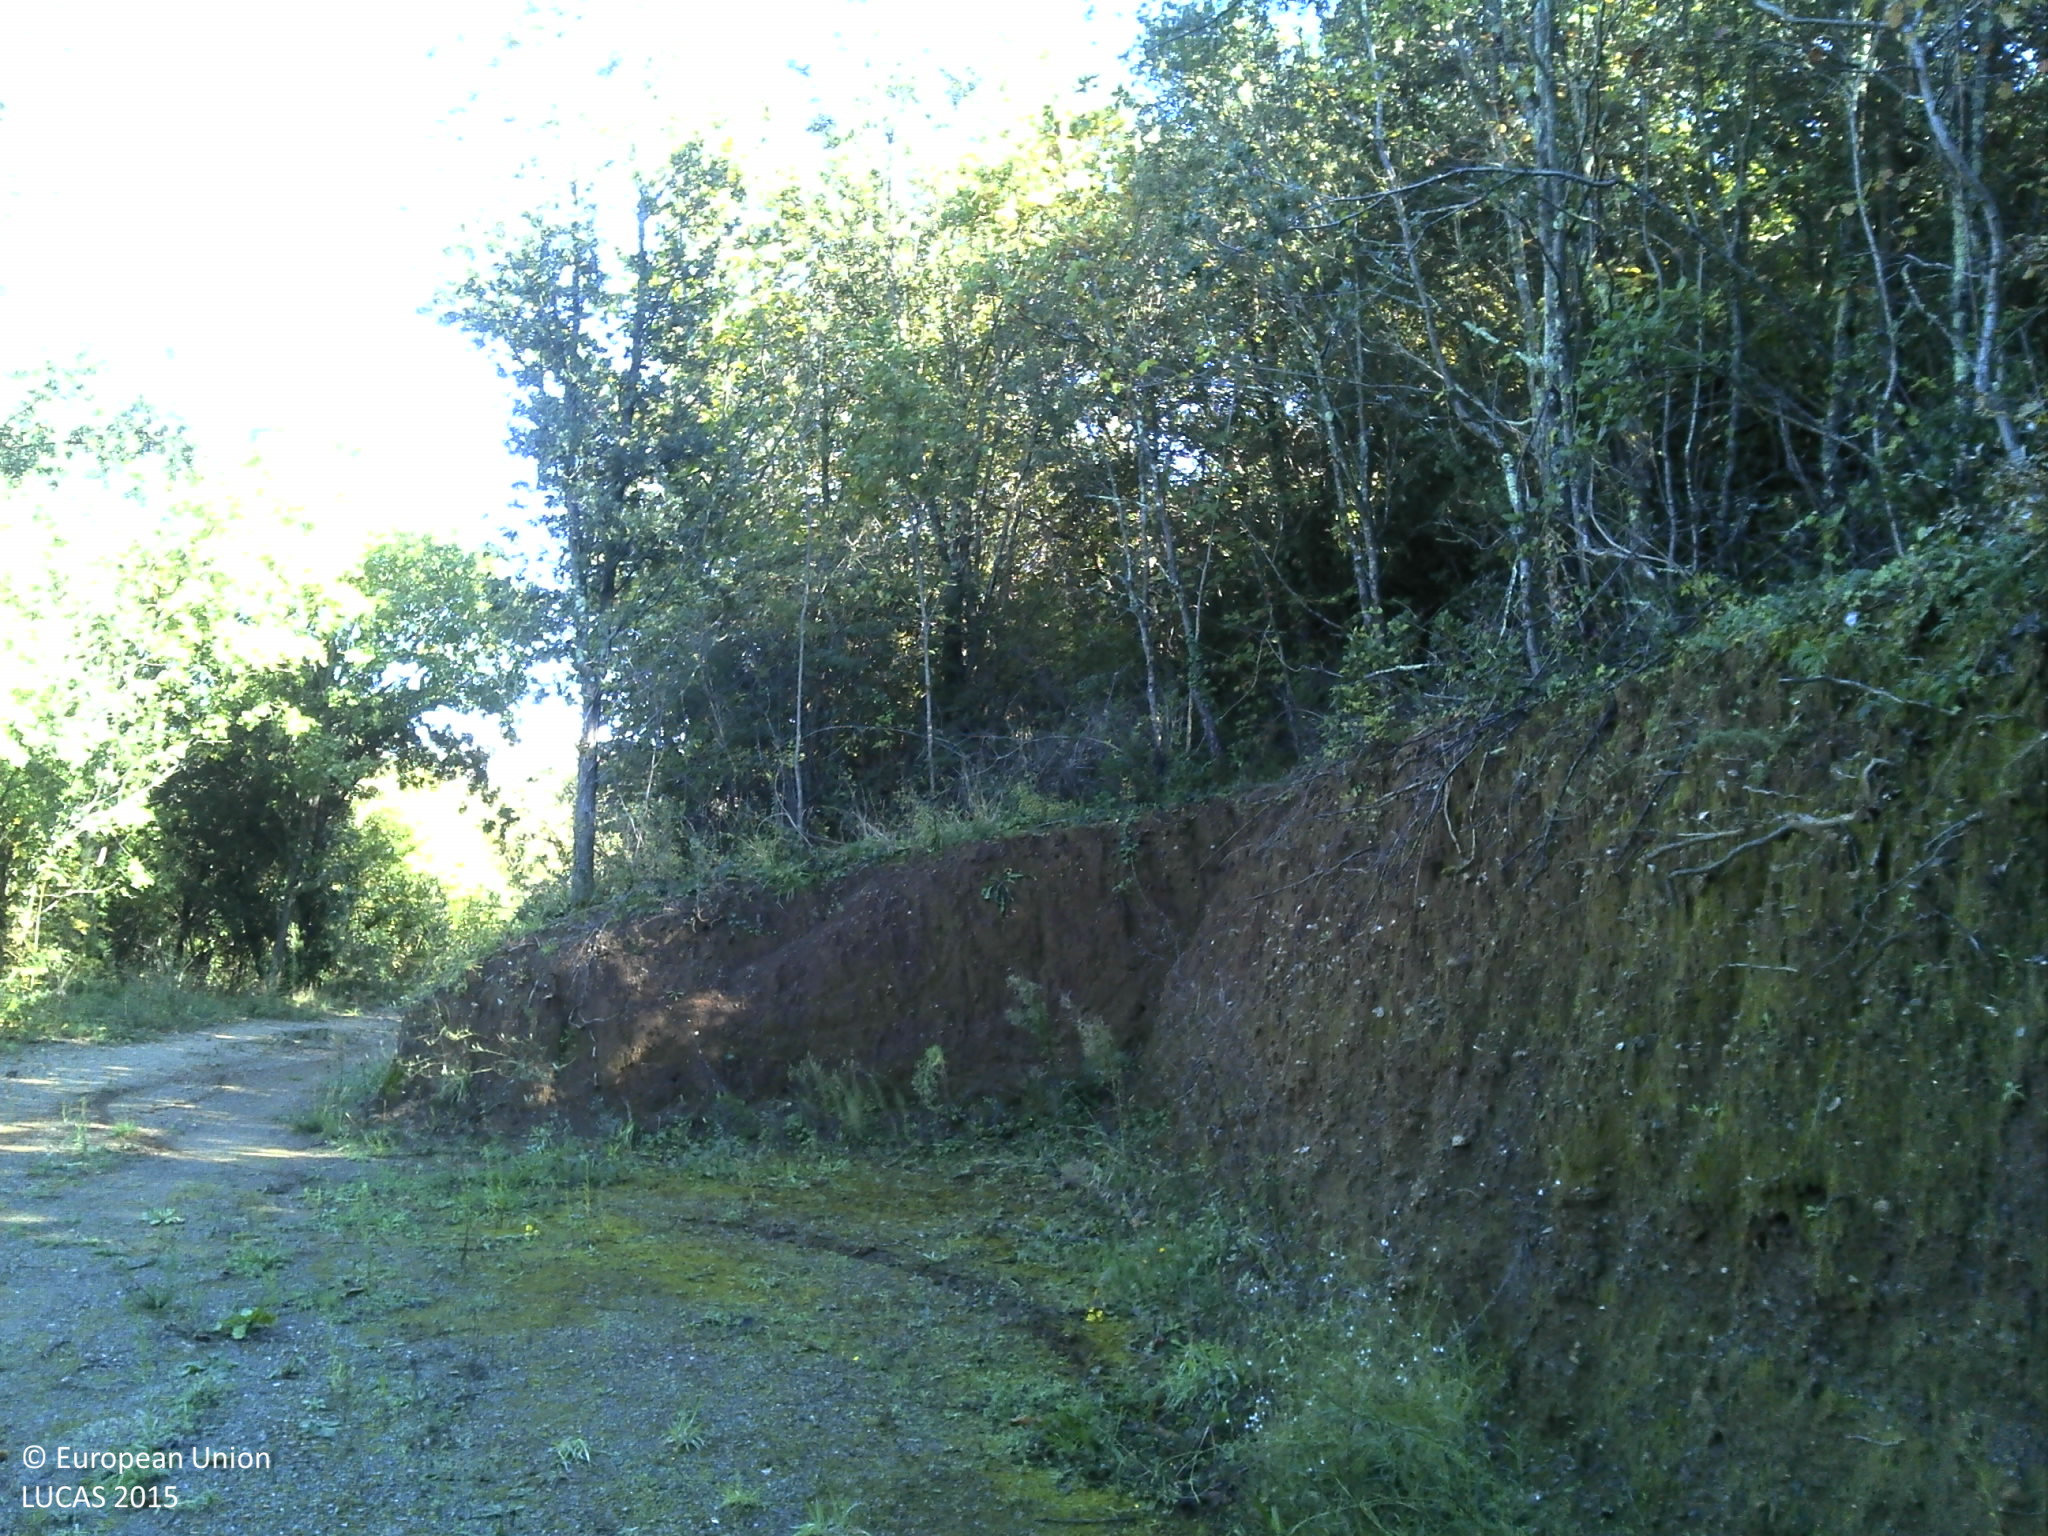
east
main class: Woodland
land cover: Broadleaved woodland
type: mesophytic deciduous forest
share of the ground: > 75 %
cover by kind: broadleaved forest trees 90 %, herbaceous plants 5 %, lichens and mosses 5 %
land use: Forestry
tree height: > 5 m
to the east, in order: Broadleaved woodland; Tracks; Broadleaved woodland; Grassland without tree/shrub cover; Broadleaved woodland; Paved roads, cycling and walking lanes; Broadleaved woodland
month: October
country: FR
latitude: 43.5801
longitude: 3.1352
